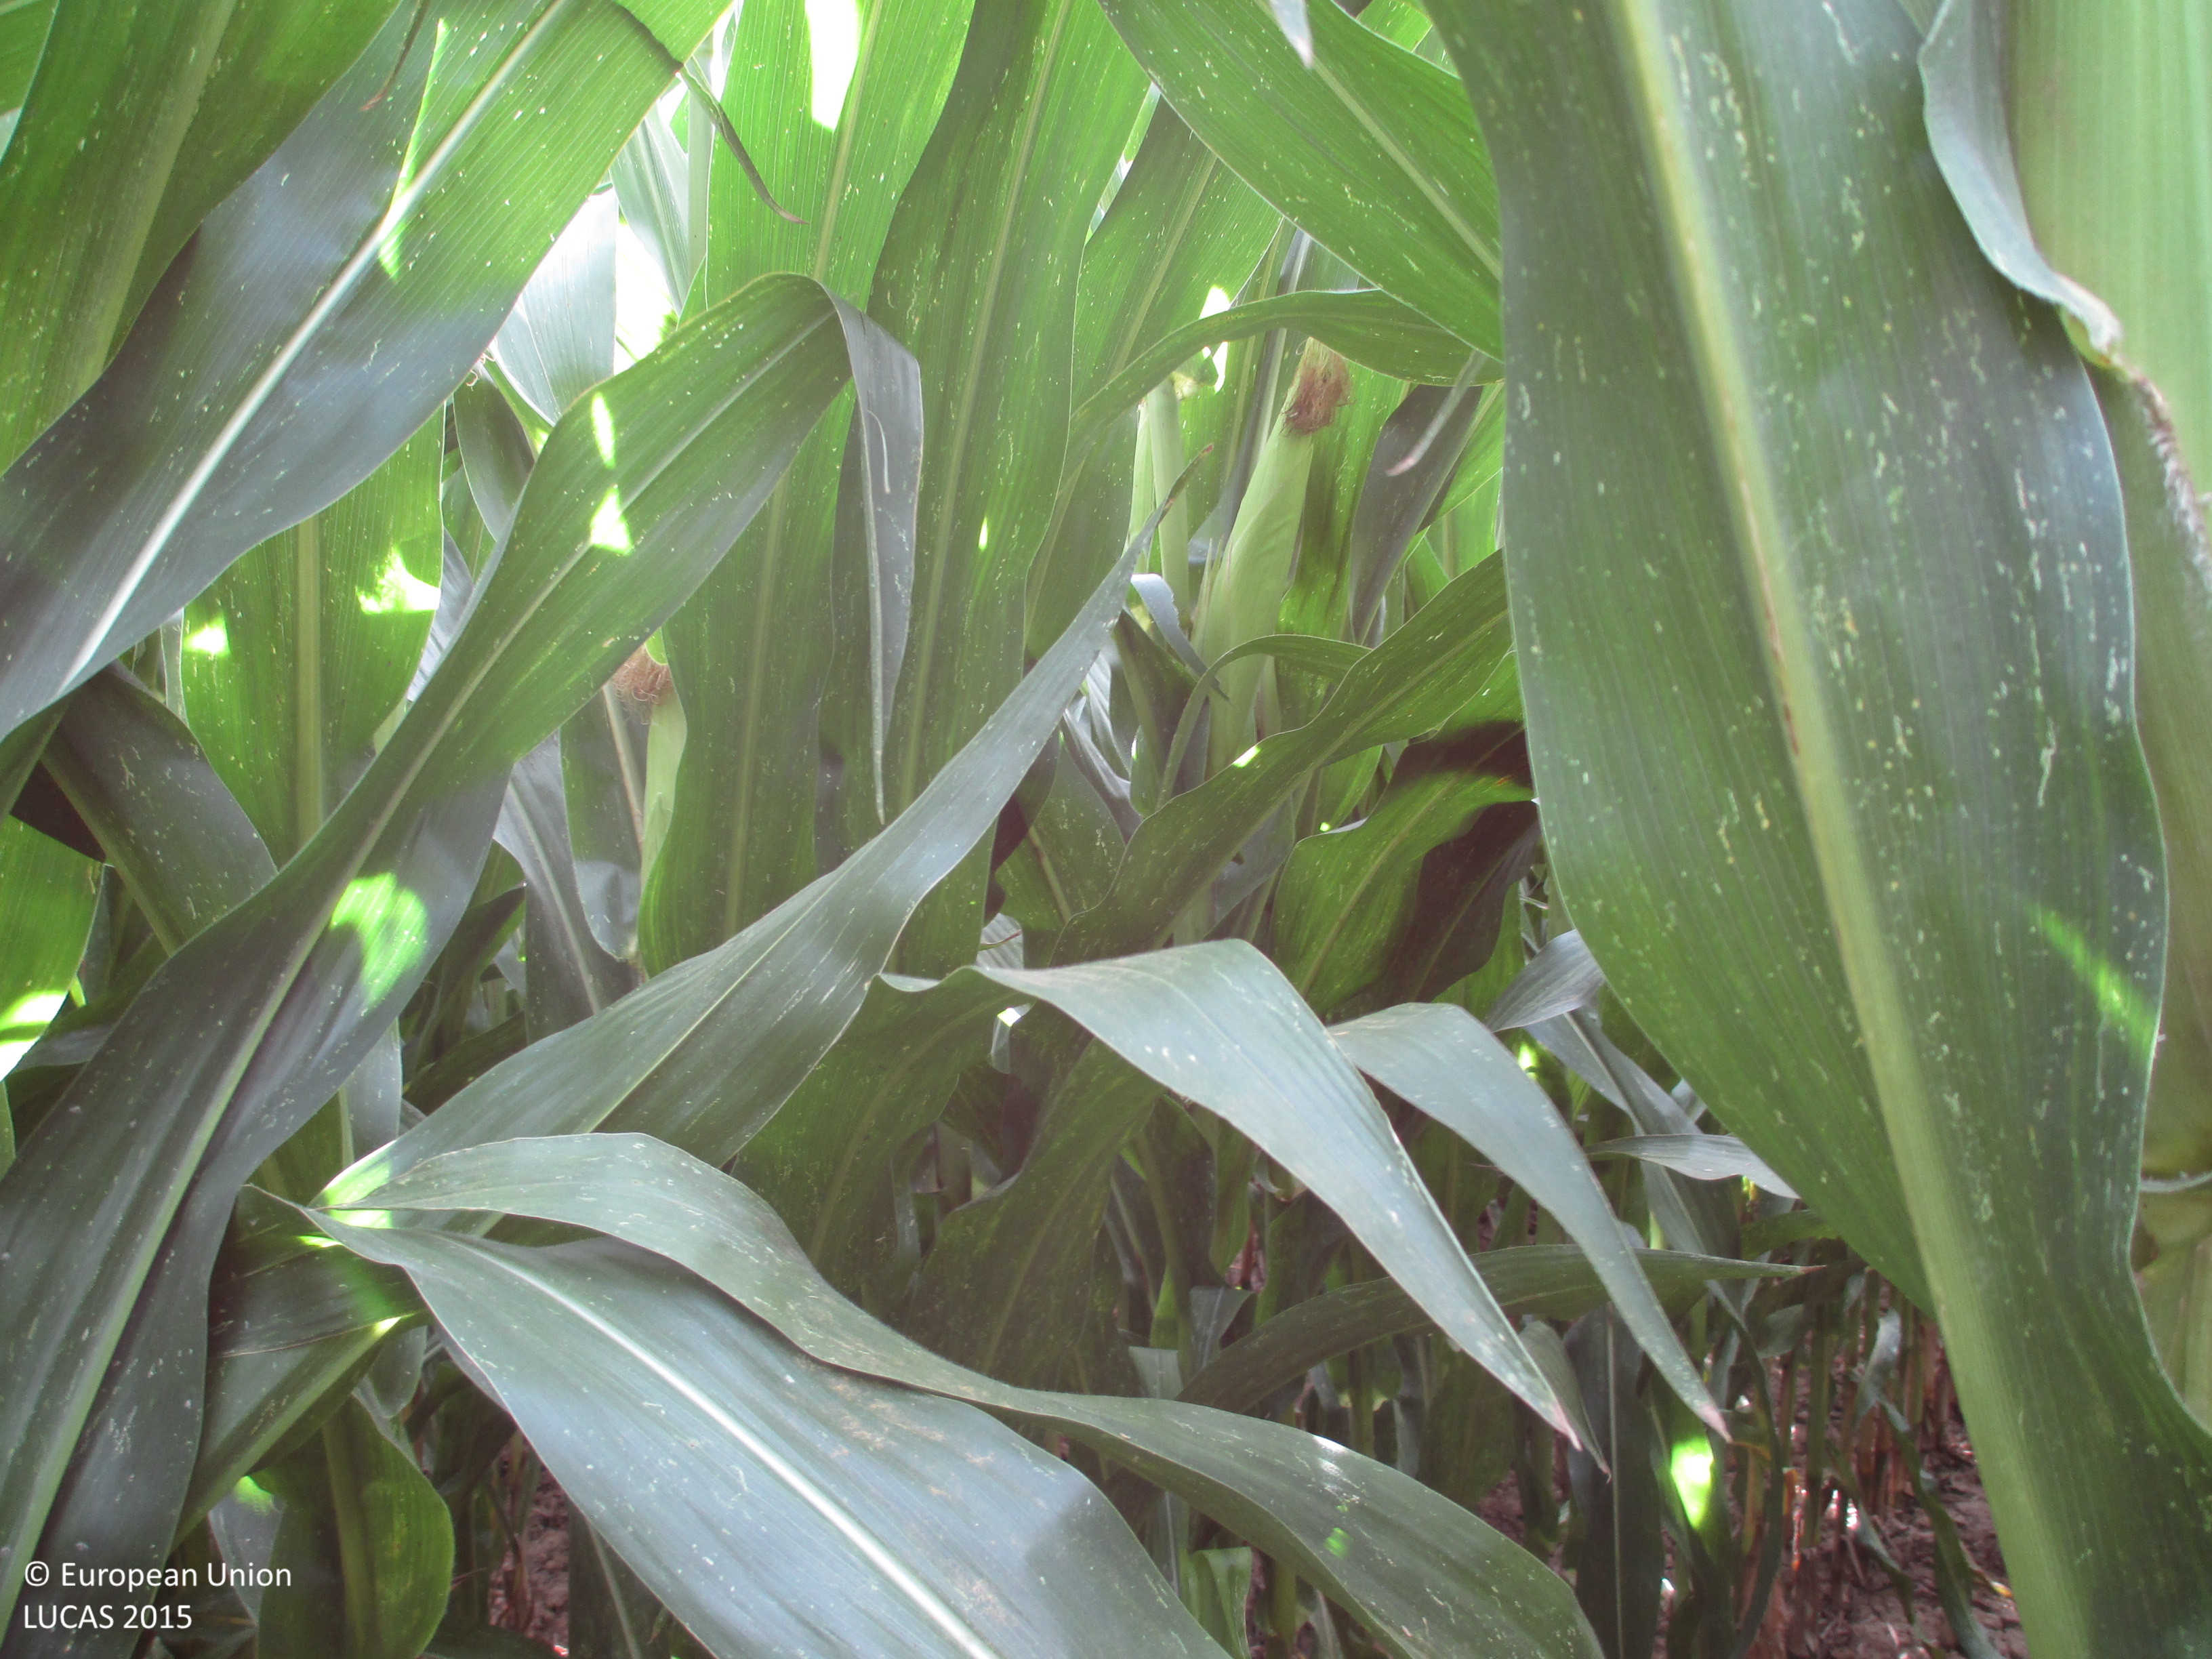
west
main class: Cropland
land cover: Maize
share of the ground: > 75 %
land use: Agriculture (excluding fallow land and kitchen gardens)
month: July
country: ES
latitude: 41.9762
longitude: 0.0010
